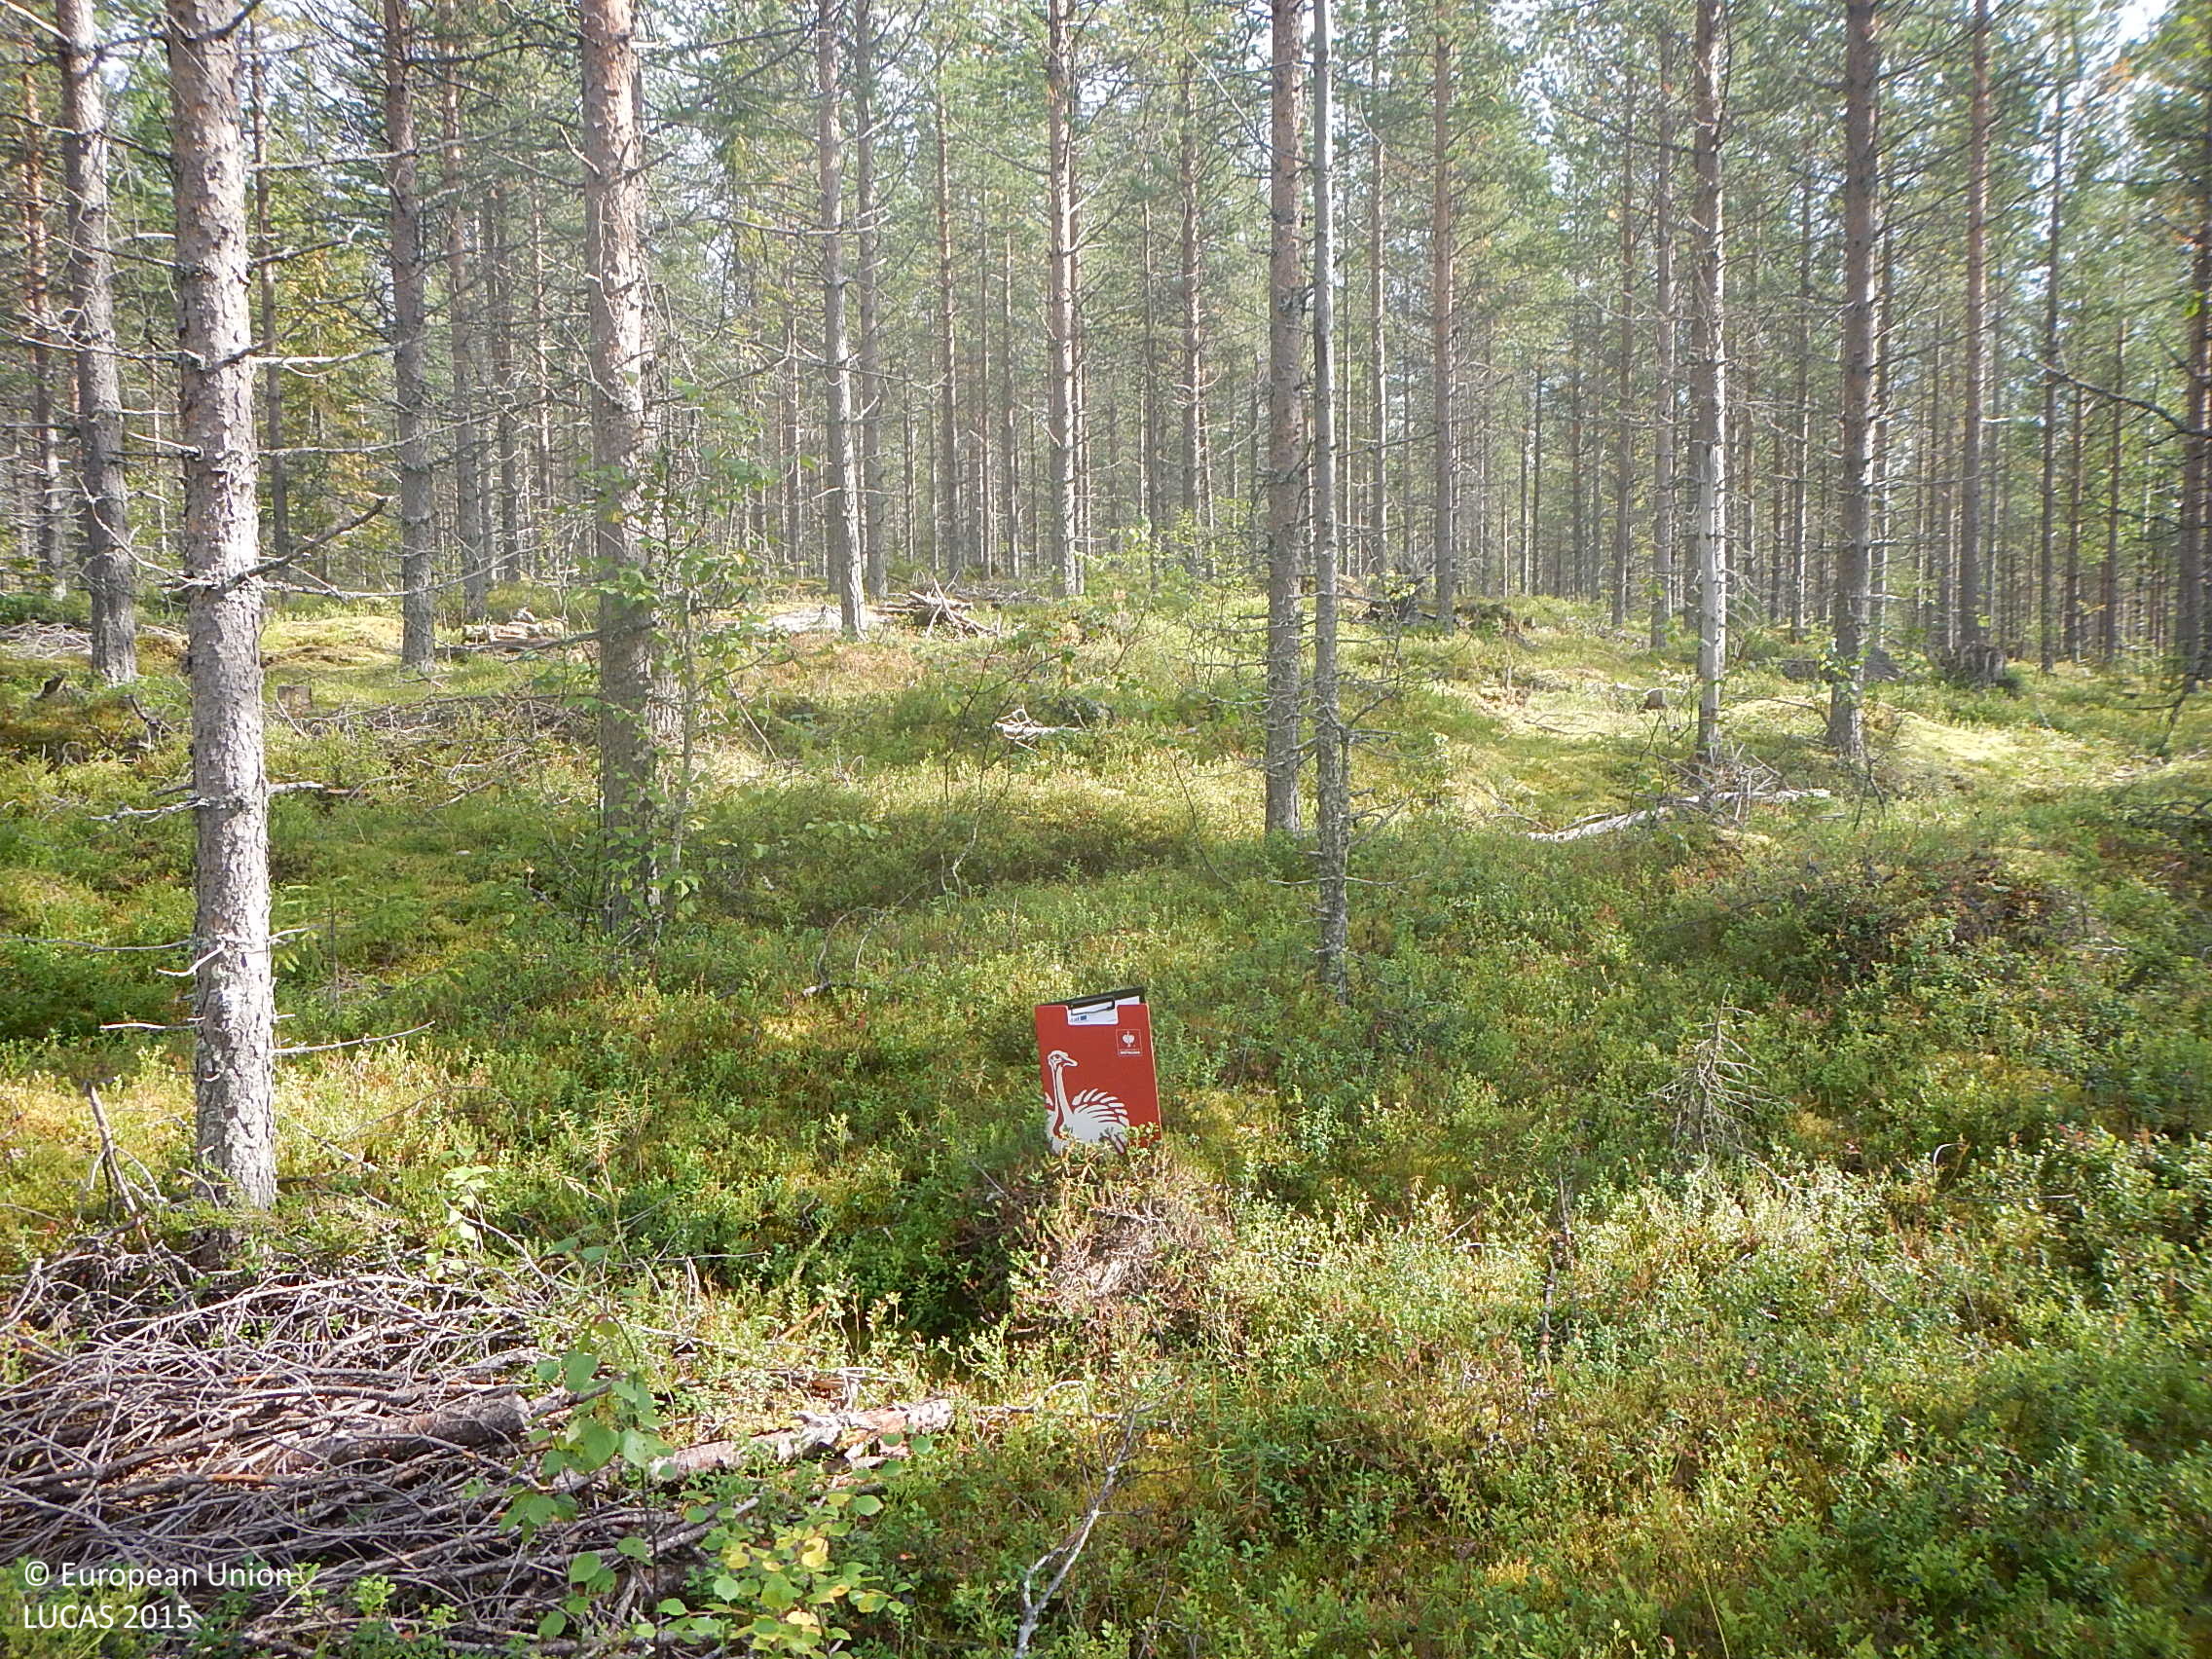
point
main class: Woodland
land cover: Pine dominated coniferous woodland
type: boreal forest
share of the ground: > 75 %
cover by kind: coniferous forest trees 75 %, shrubs 20 %, lichens and mosses 5 %
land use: Forestry
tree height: > 5 m
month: August
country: FI
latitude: 66.1199
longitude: 27.4522
